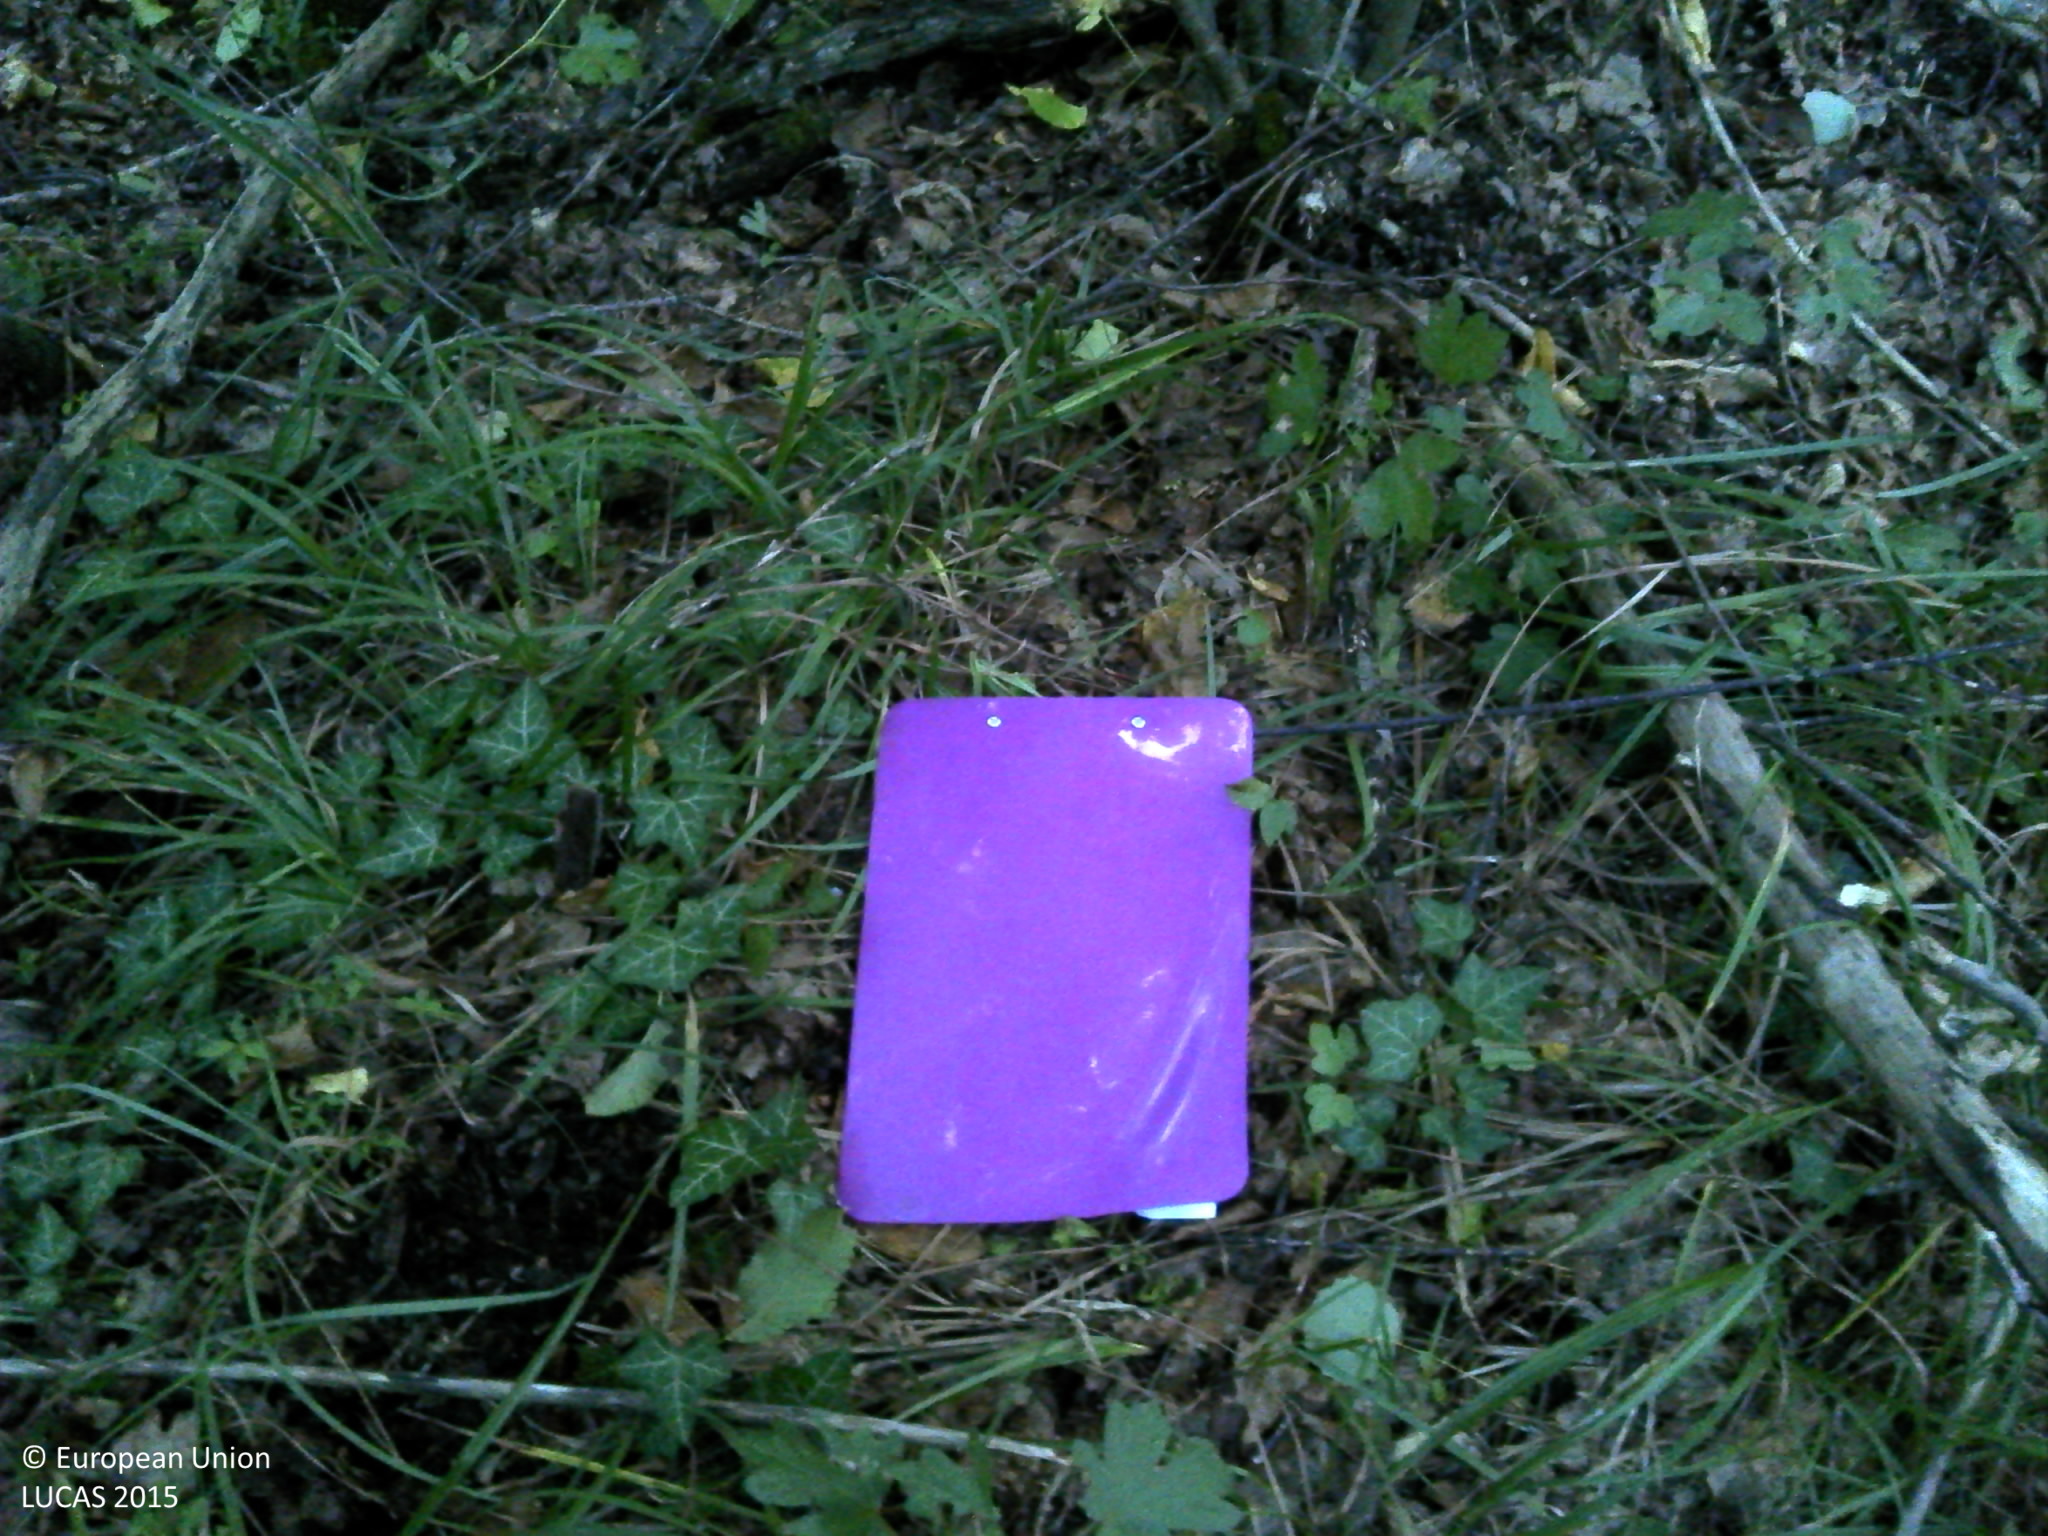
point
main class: Woodland
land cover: Broadleaved woodland
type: beech forest
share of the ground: > 75 %
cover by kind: broadleaved forest trees 100 %
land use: Forestry
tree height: > 5 m
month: August
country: HR
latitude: 45.2852
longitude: 16.5124
